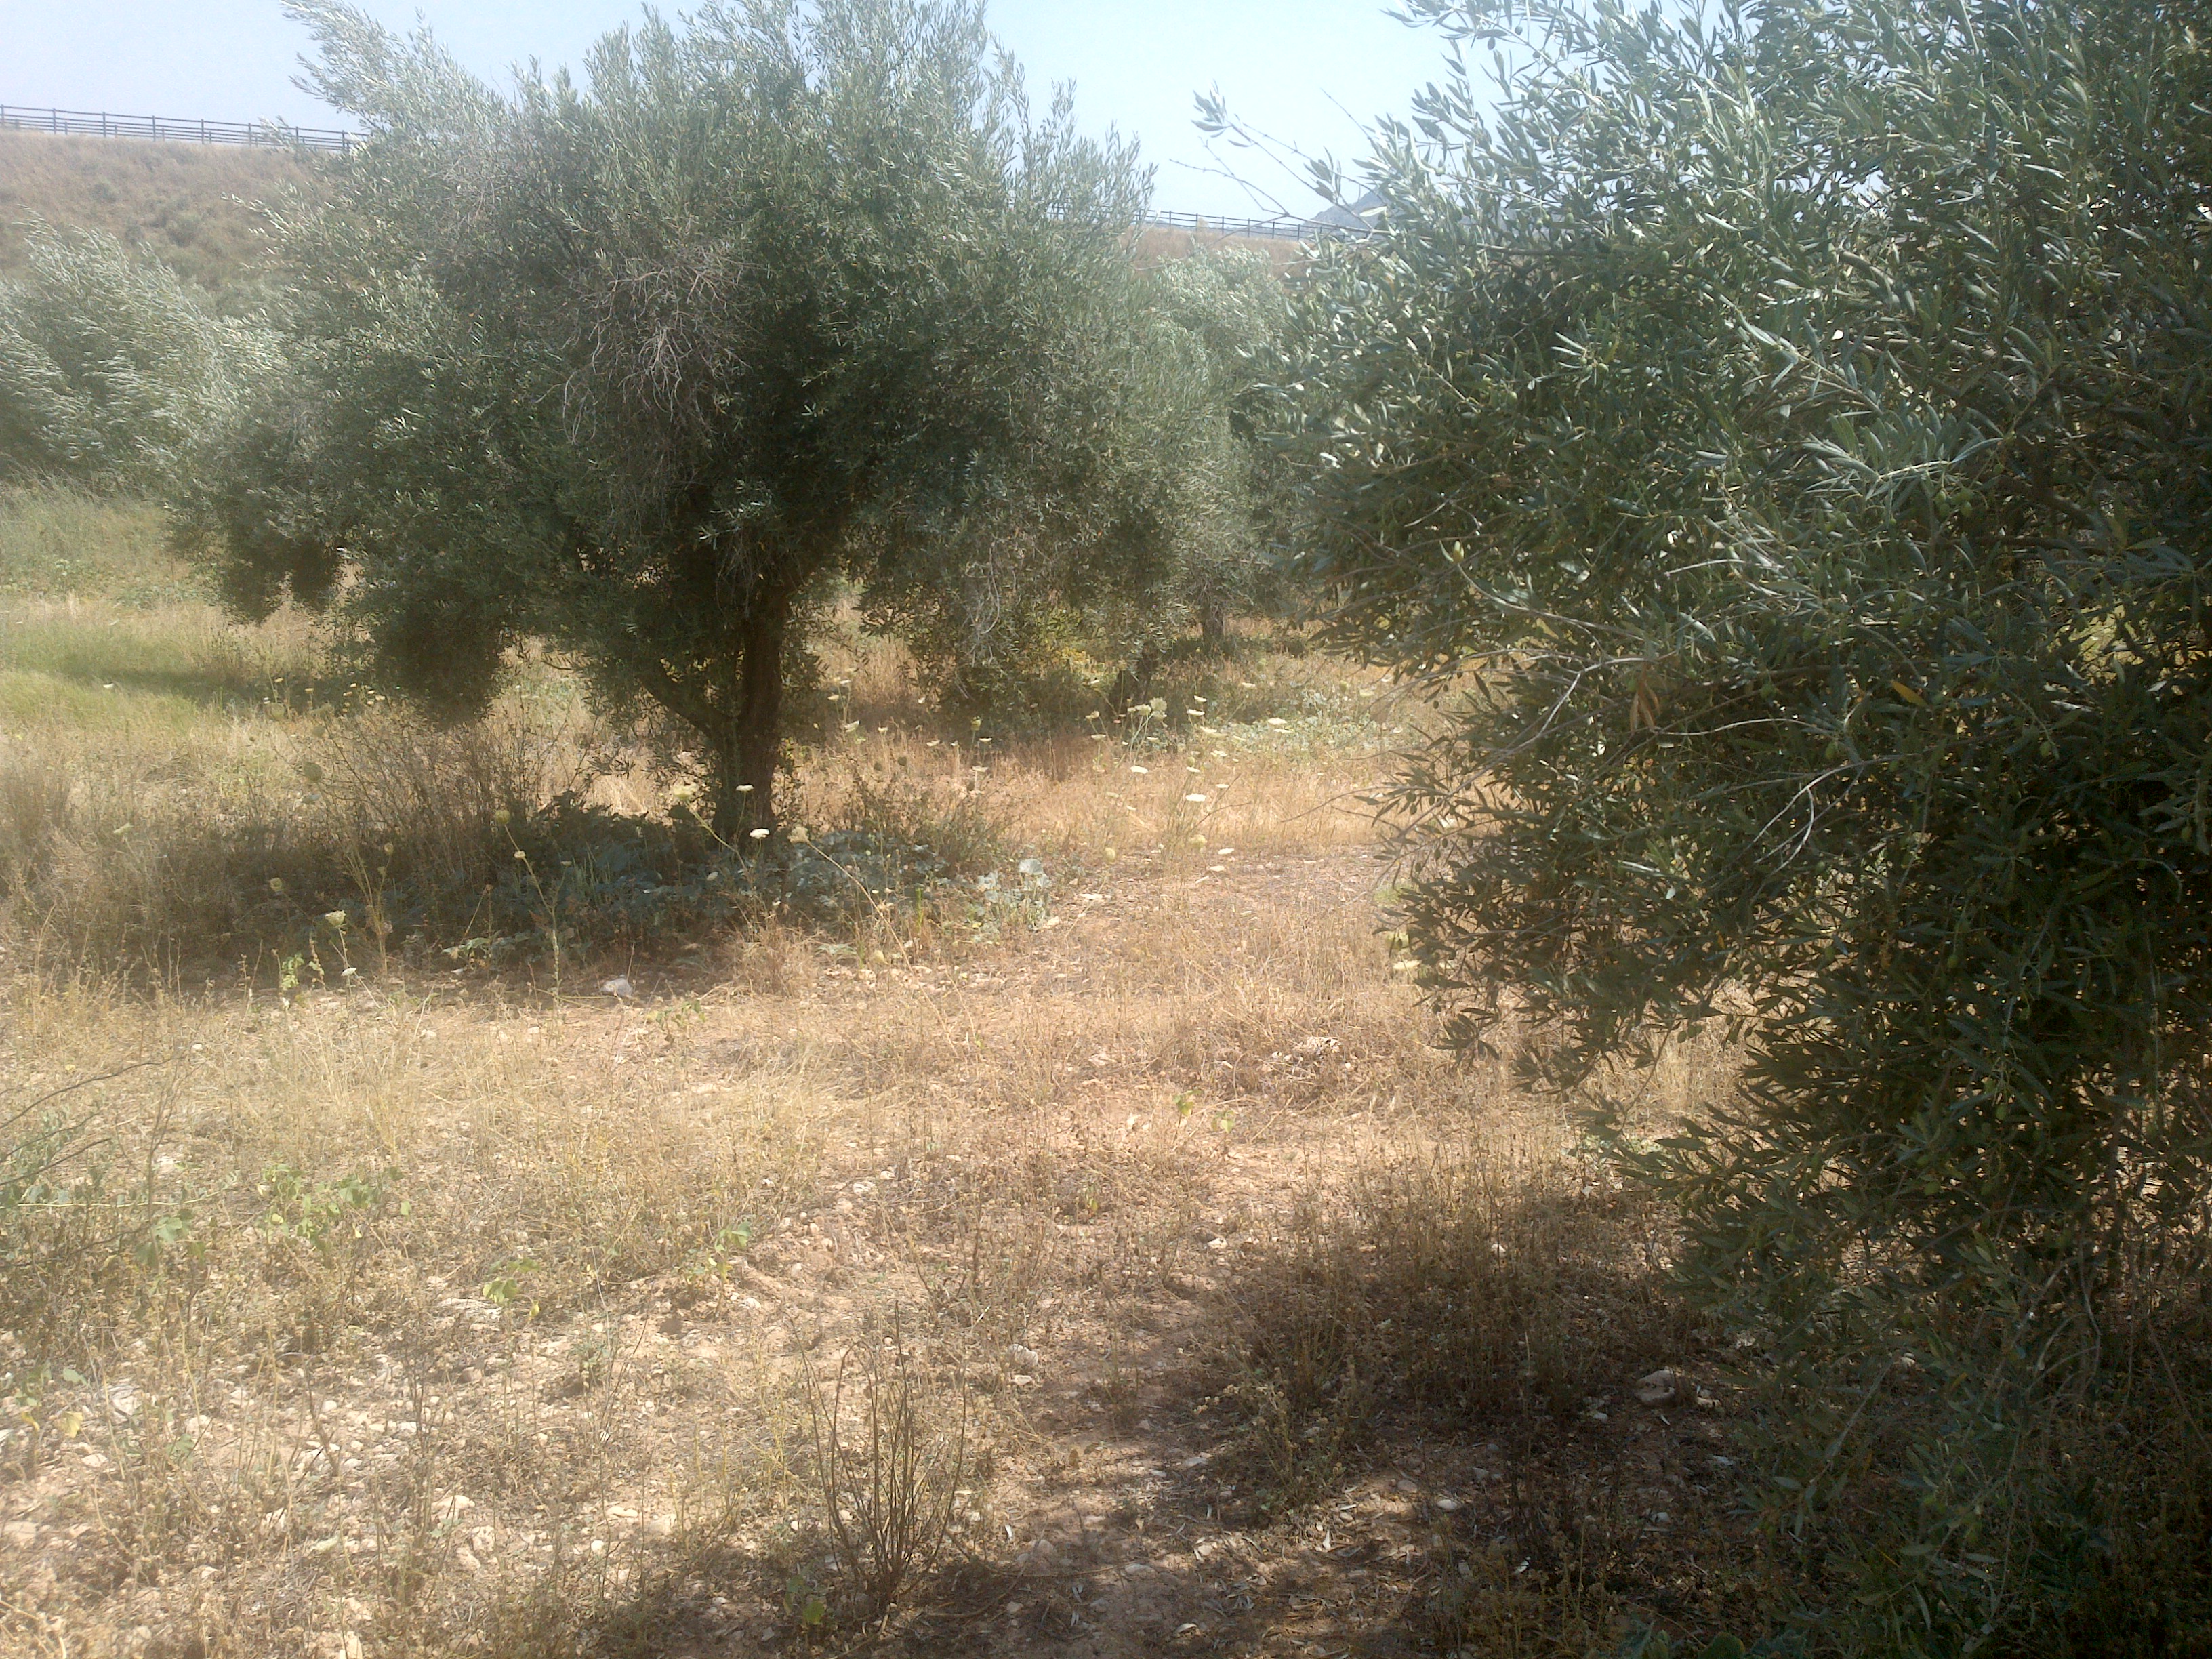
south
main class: Cropland
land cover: Olive groves
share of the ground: 25 - 50 %
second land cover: Spontaneously vegetated surfaces
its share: 10 - 25 %
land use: Agriculture (excluding fallow land and kitchen gardens)
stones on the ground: 25 - 50 %
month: June
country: ES
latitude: 37.5714
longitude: -4.2345
